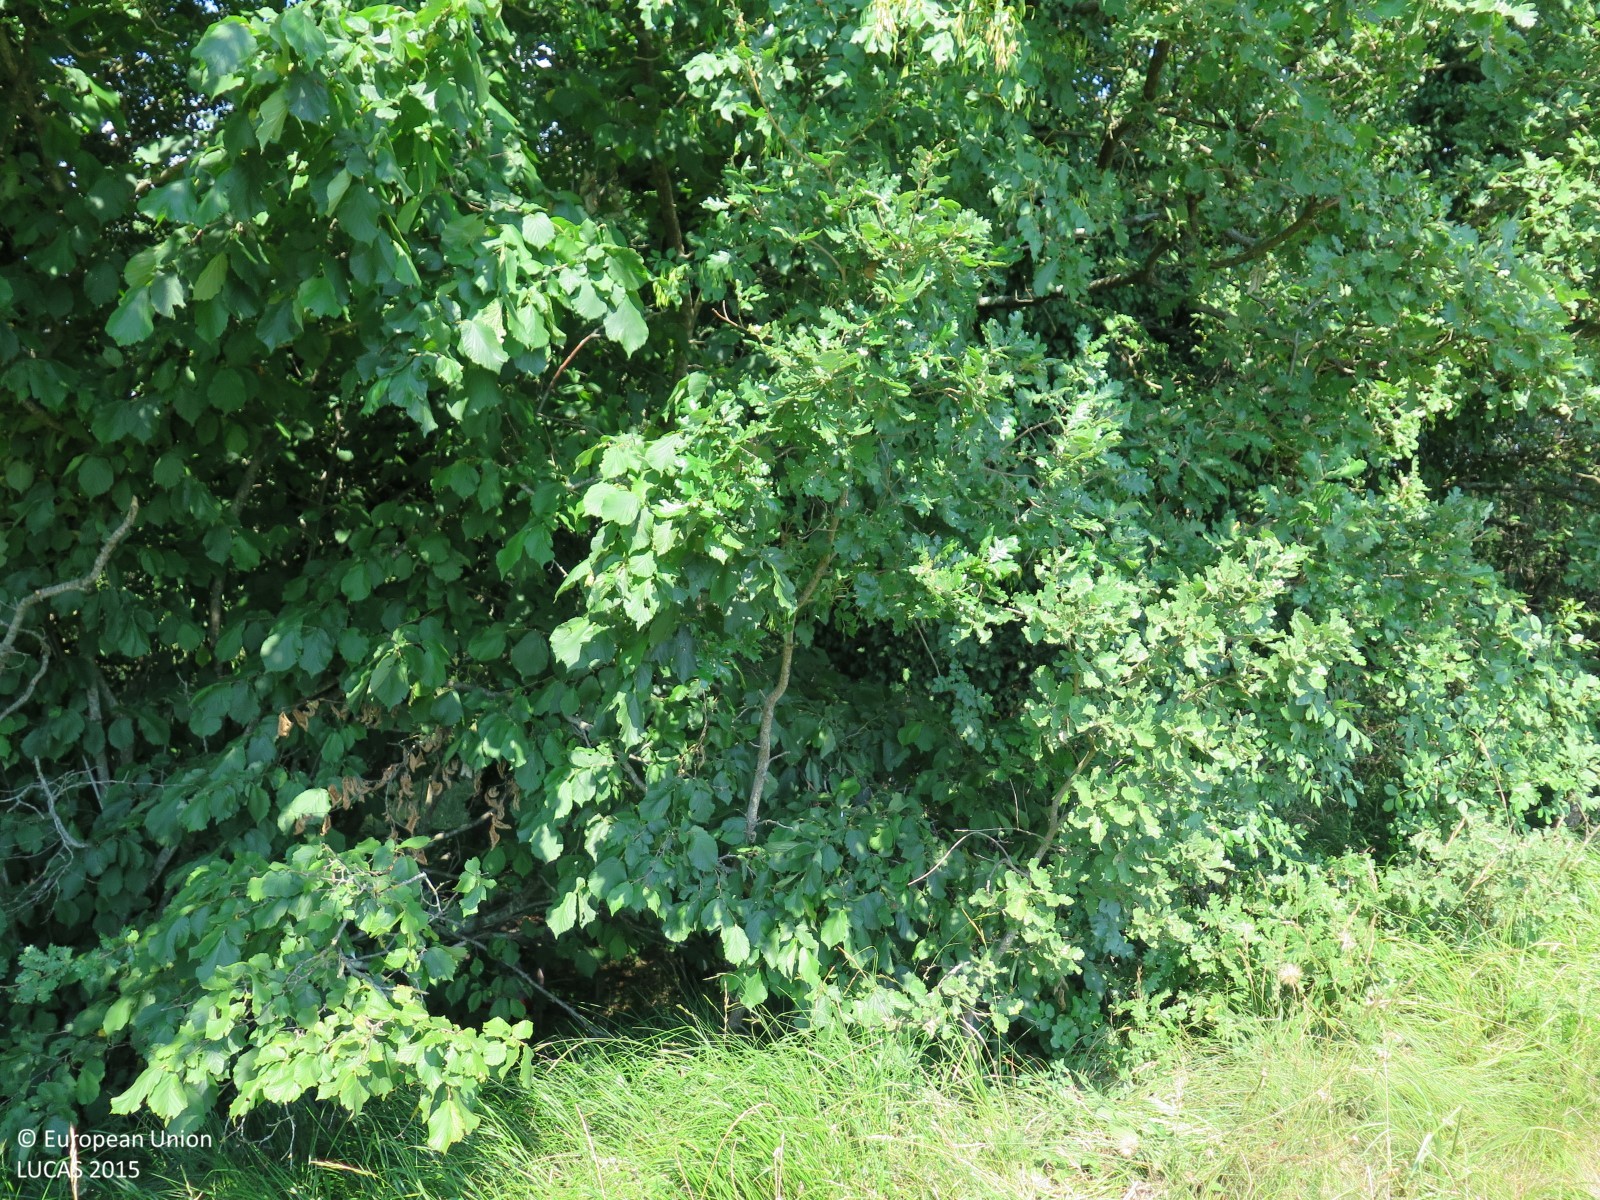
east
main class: Grassland
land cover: Grassland with sparse tree/shrub cover
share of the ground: > 75 %
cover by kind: herbaceous plants 90 %, broadleaved forest trees 5 %, shrubs 5 %
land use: Agriculture (excluding fallow land and kitchen gardens)
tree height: < 5 m
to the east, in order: Grassland with sparse tree/shrub cover; Fences; Tracks; Grassland without tree/shrub cover; Apple fruit; Cherry fruit; Lines of trees; Grassland with sparse tree/shrub cover; Grassland without tree/shrub cover; Broadleaved woodland; Grass margins; Sunflower; Broadleaved woodland; Shrubland without tree cover; Tracks
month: July
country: HR
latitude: 45.2185
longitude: 13.8278
